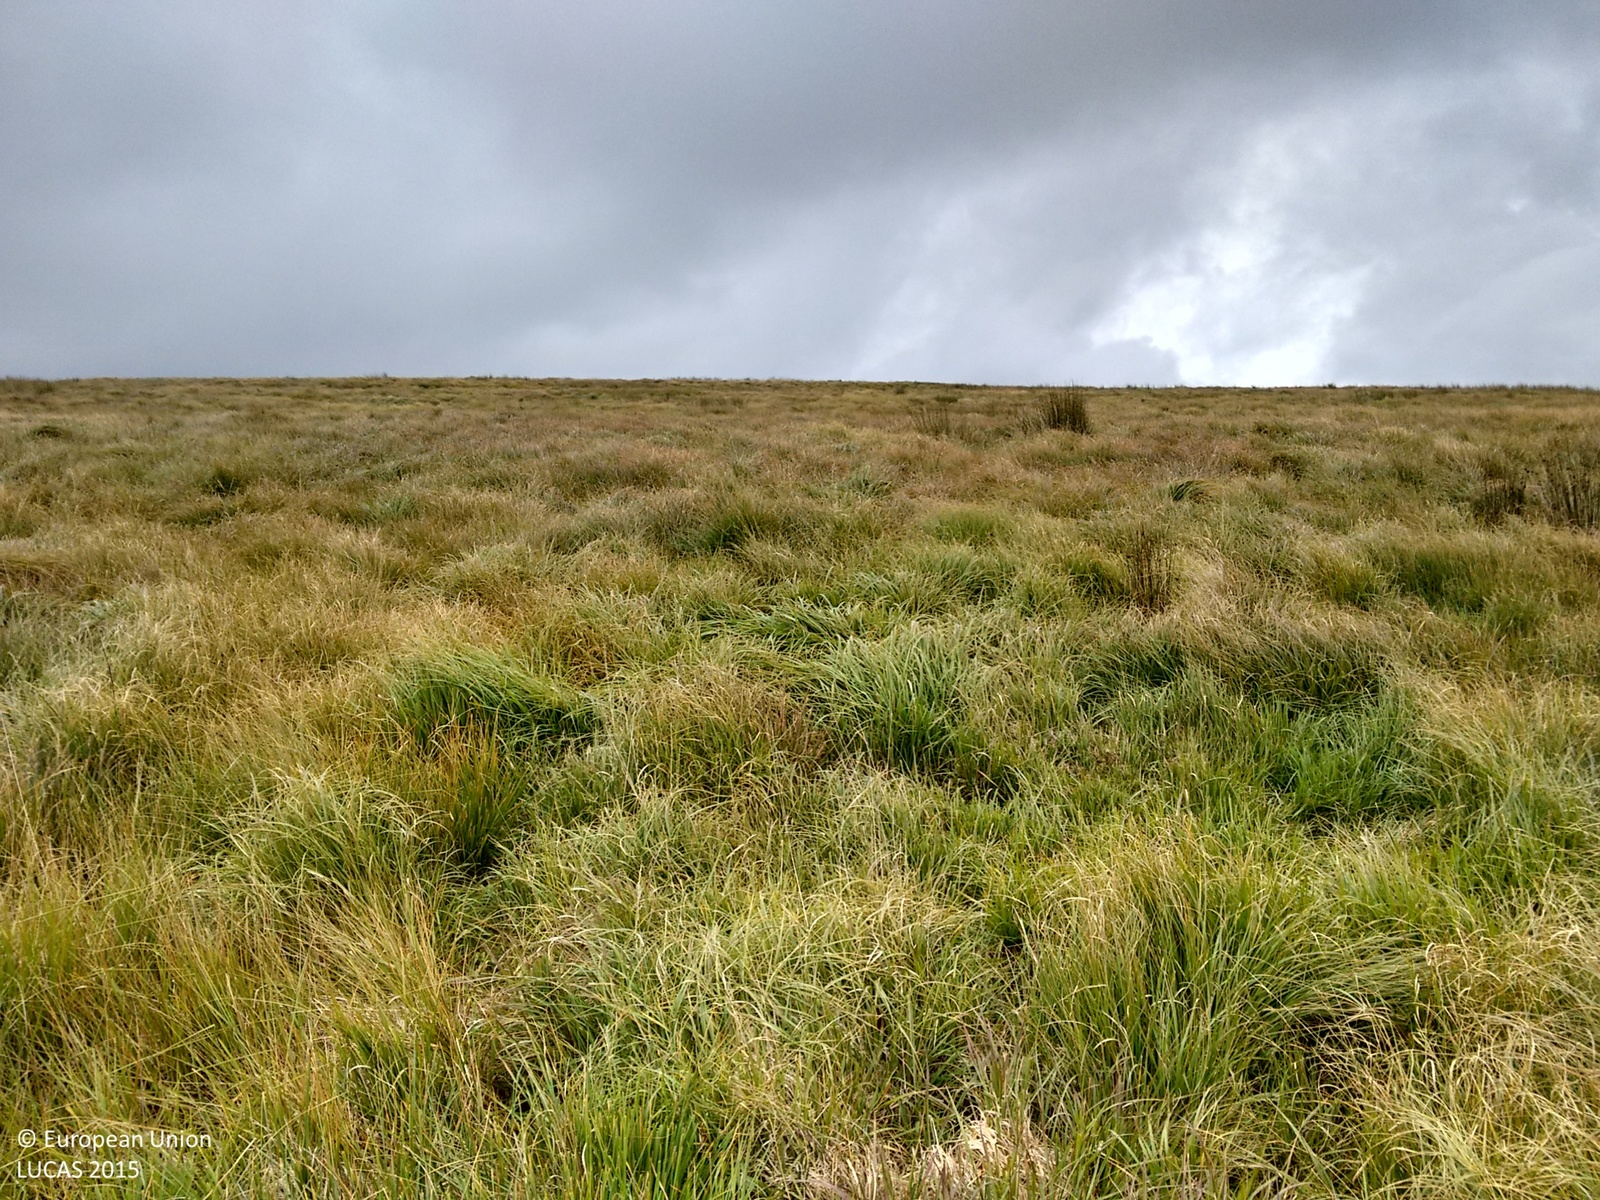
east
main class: Grassland
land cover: Grassland without tree/shrub cover
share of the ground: > 75 %
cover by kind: herbaceous plants 100 %
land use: Agriculture (excluding fallow land and kitchen gardens)
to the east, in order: Grassland without tree/shrub cover
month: September
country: GB
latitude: 52.2049
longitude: -3.8015
